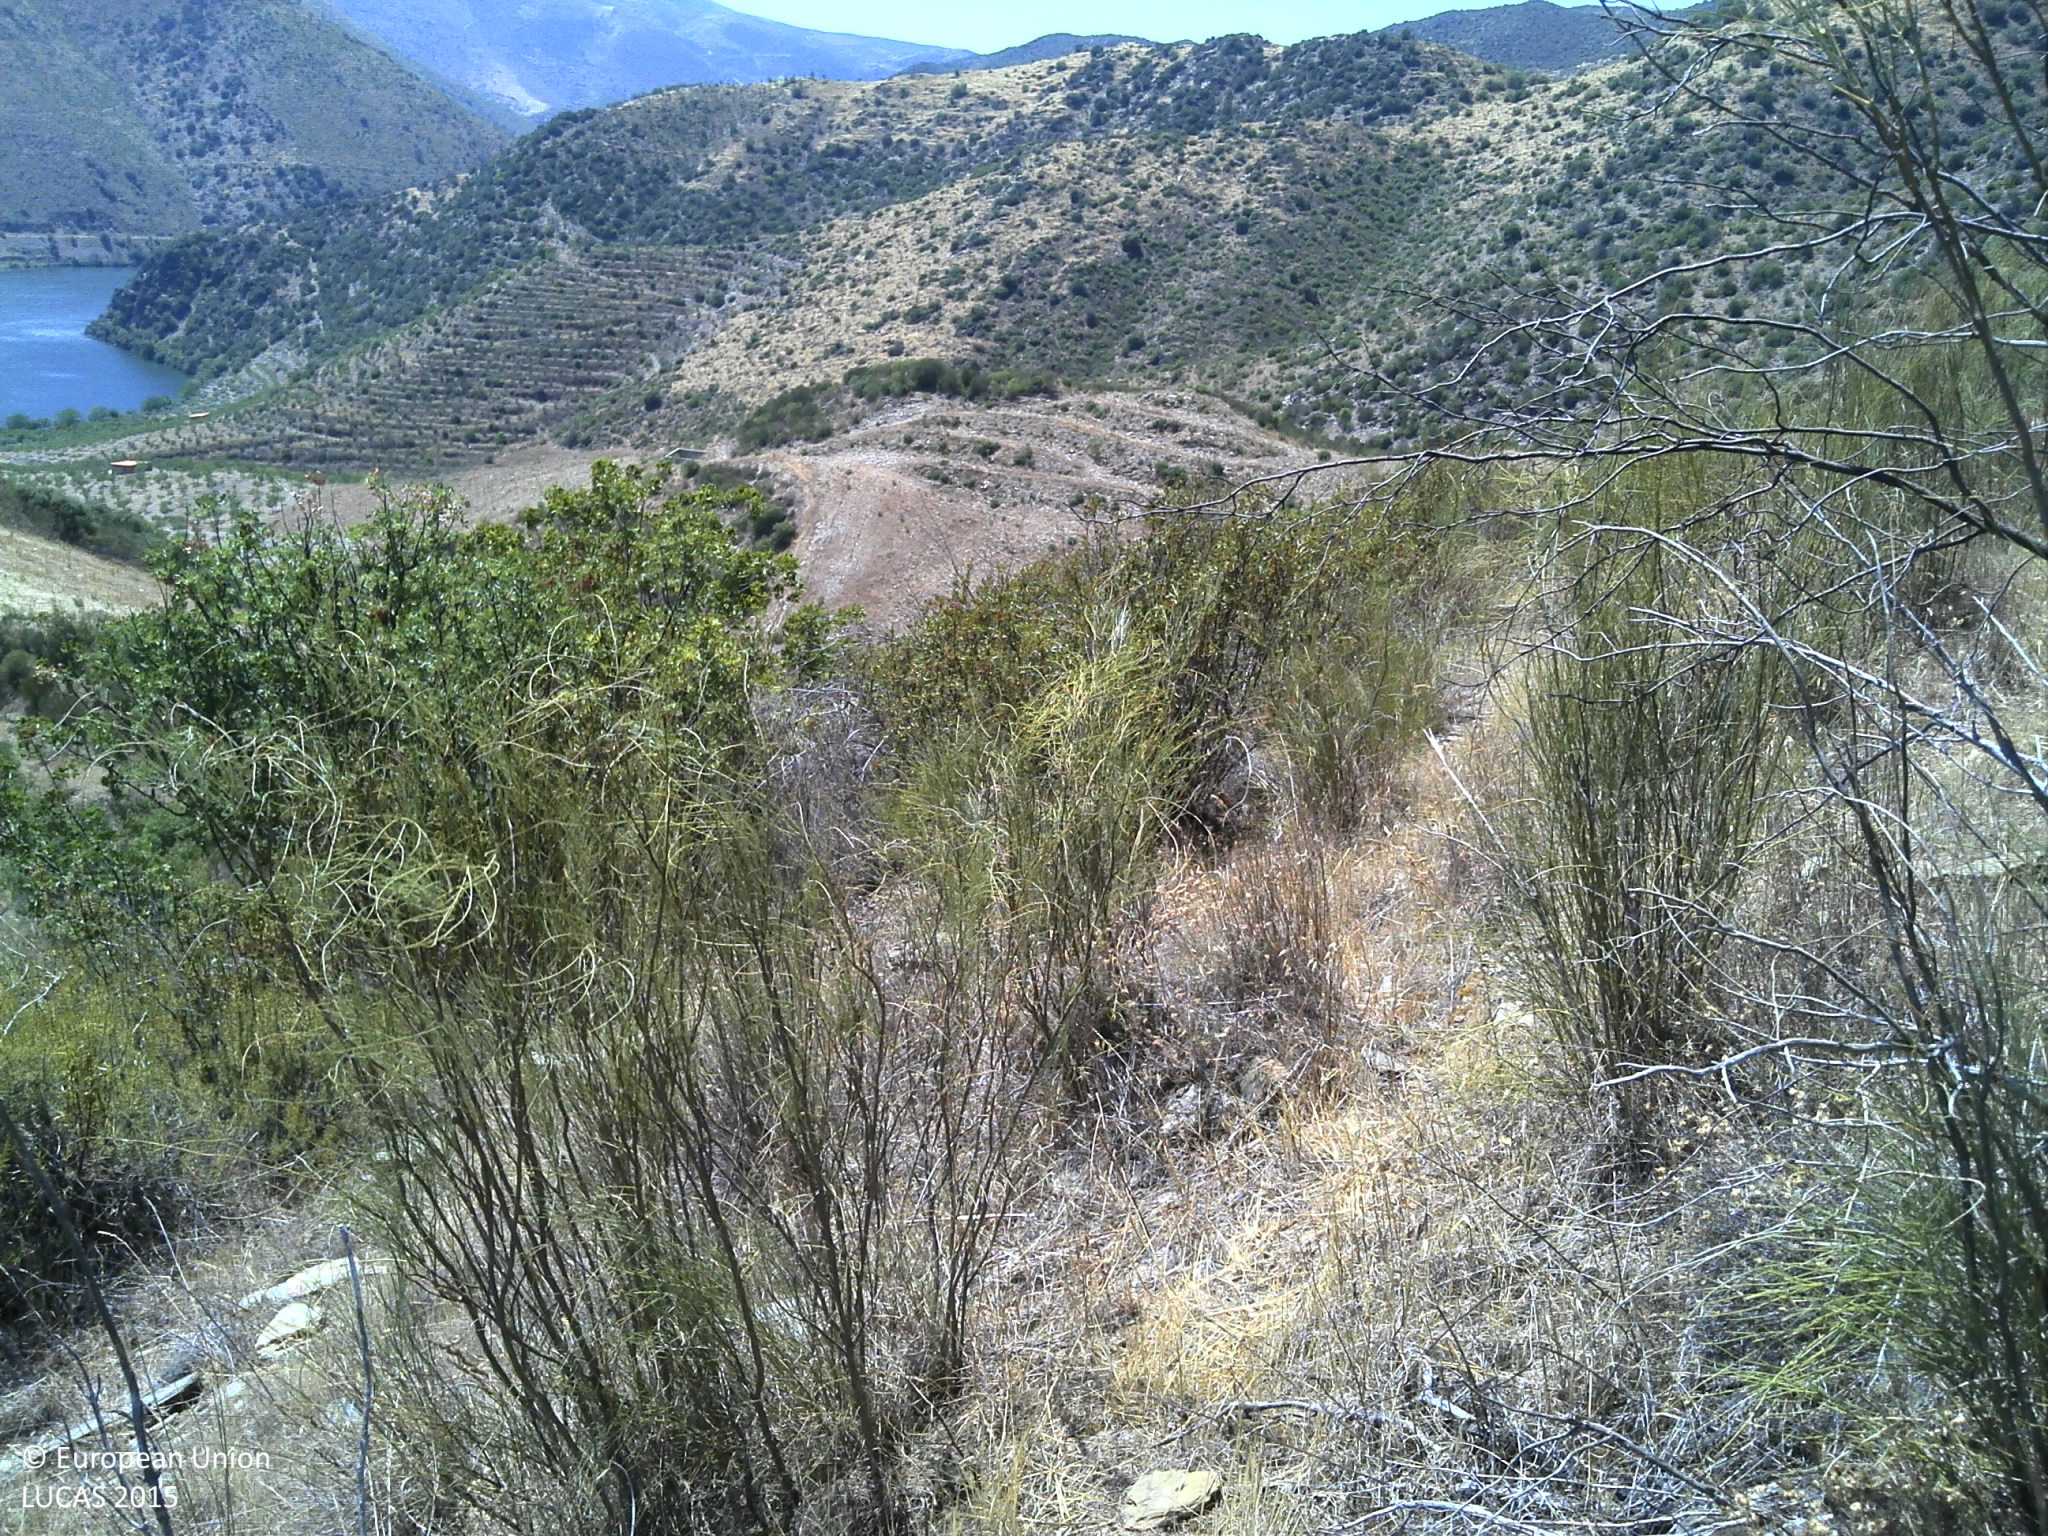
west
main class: Shrubland
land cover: Shrubland without tree cover
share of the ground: > 75 %
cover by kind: shrubs 95 %, unconsolidated bare surface 5 %
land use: Semi-natural and natural areas not in use
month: June
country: PT
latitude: 41.0409
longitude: -6.9874
